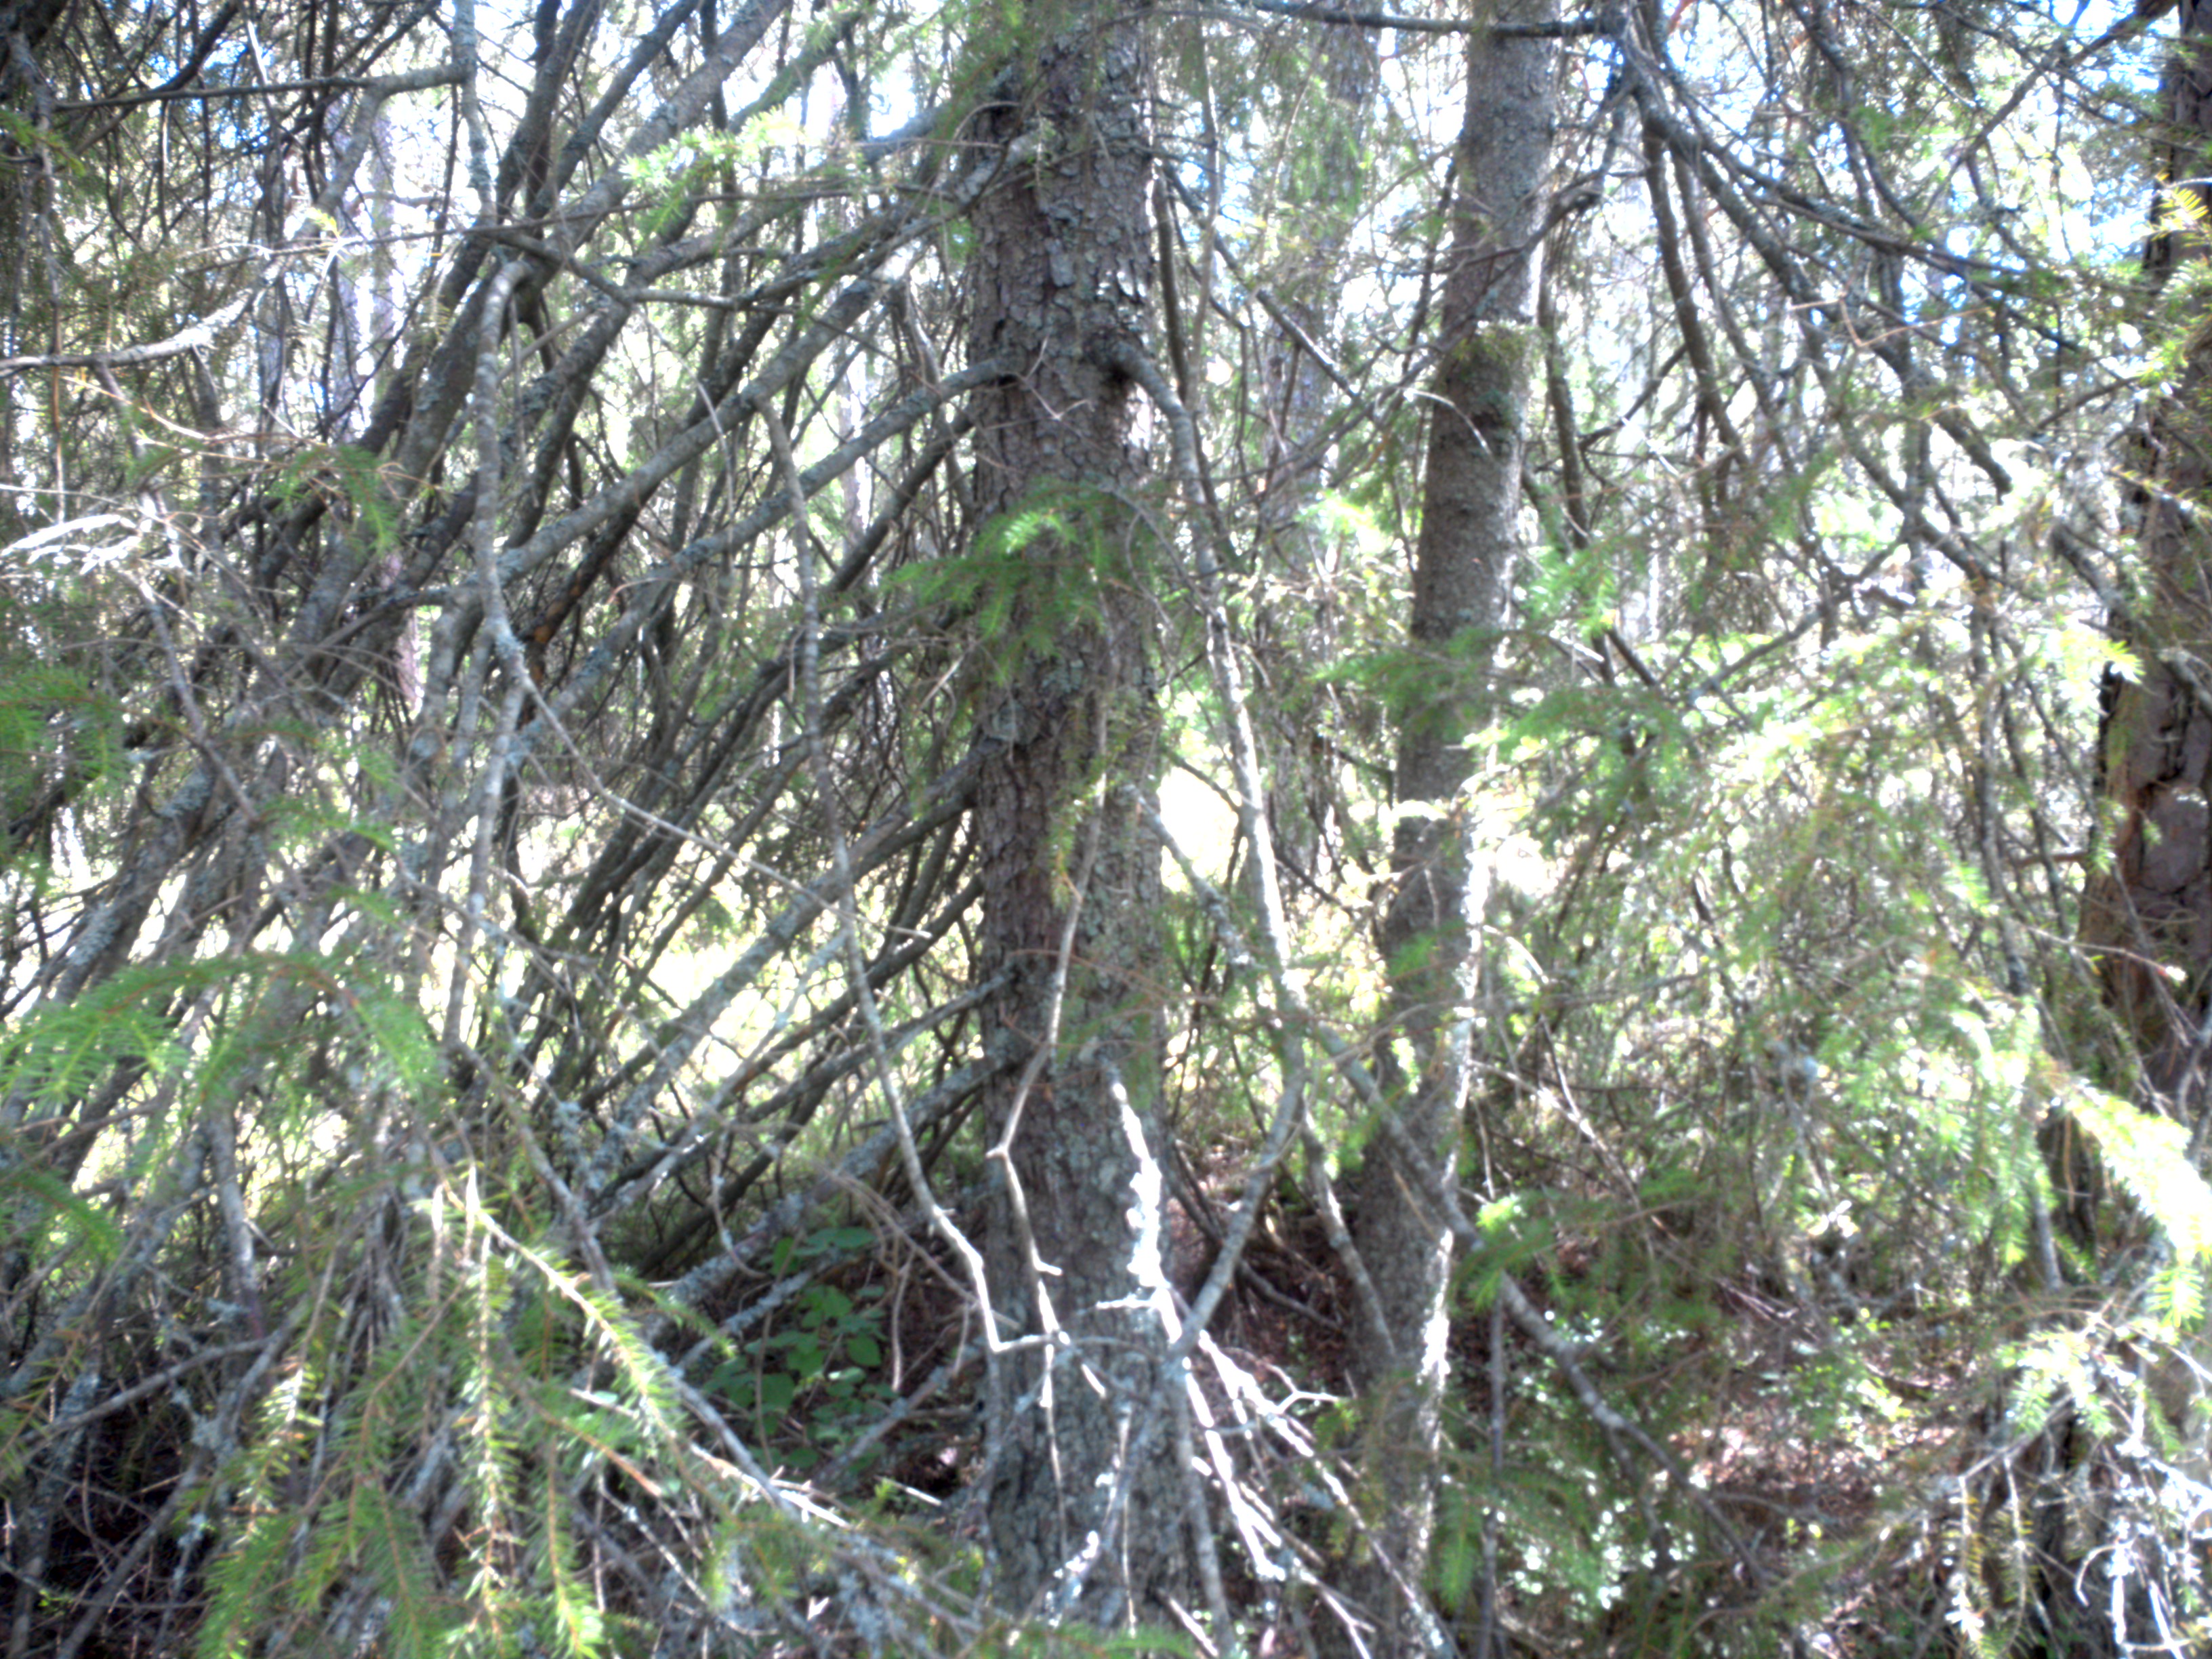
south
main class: Woodland
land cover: Pine dominated coniferous woodland
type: boreal forest
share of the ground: 25 - 50 %
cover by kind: coniferous forest trees 50 %, shrubs 45 %, lichens and mosses 5 %
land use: Amenities, museums, leisure
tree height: > 5 m
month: June
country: SE
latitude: 59.1788
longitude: 18.2419
